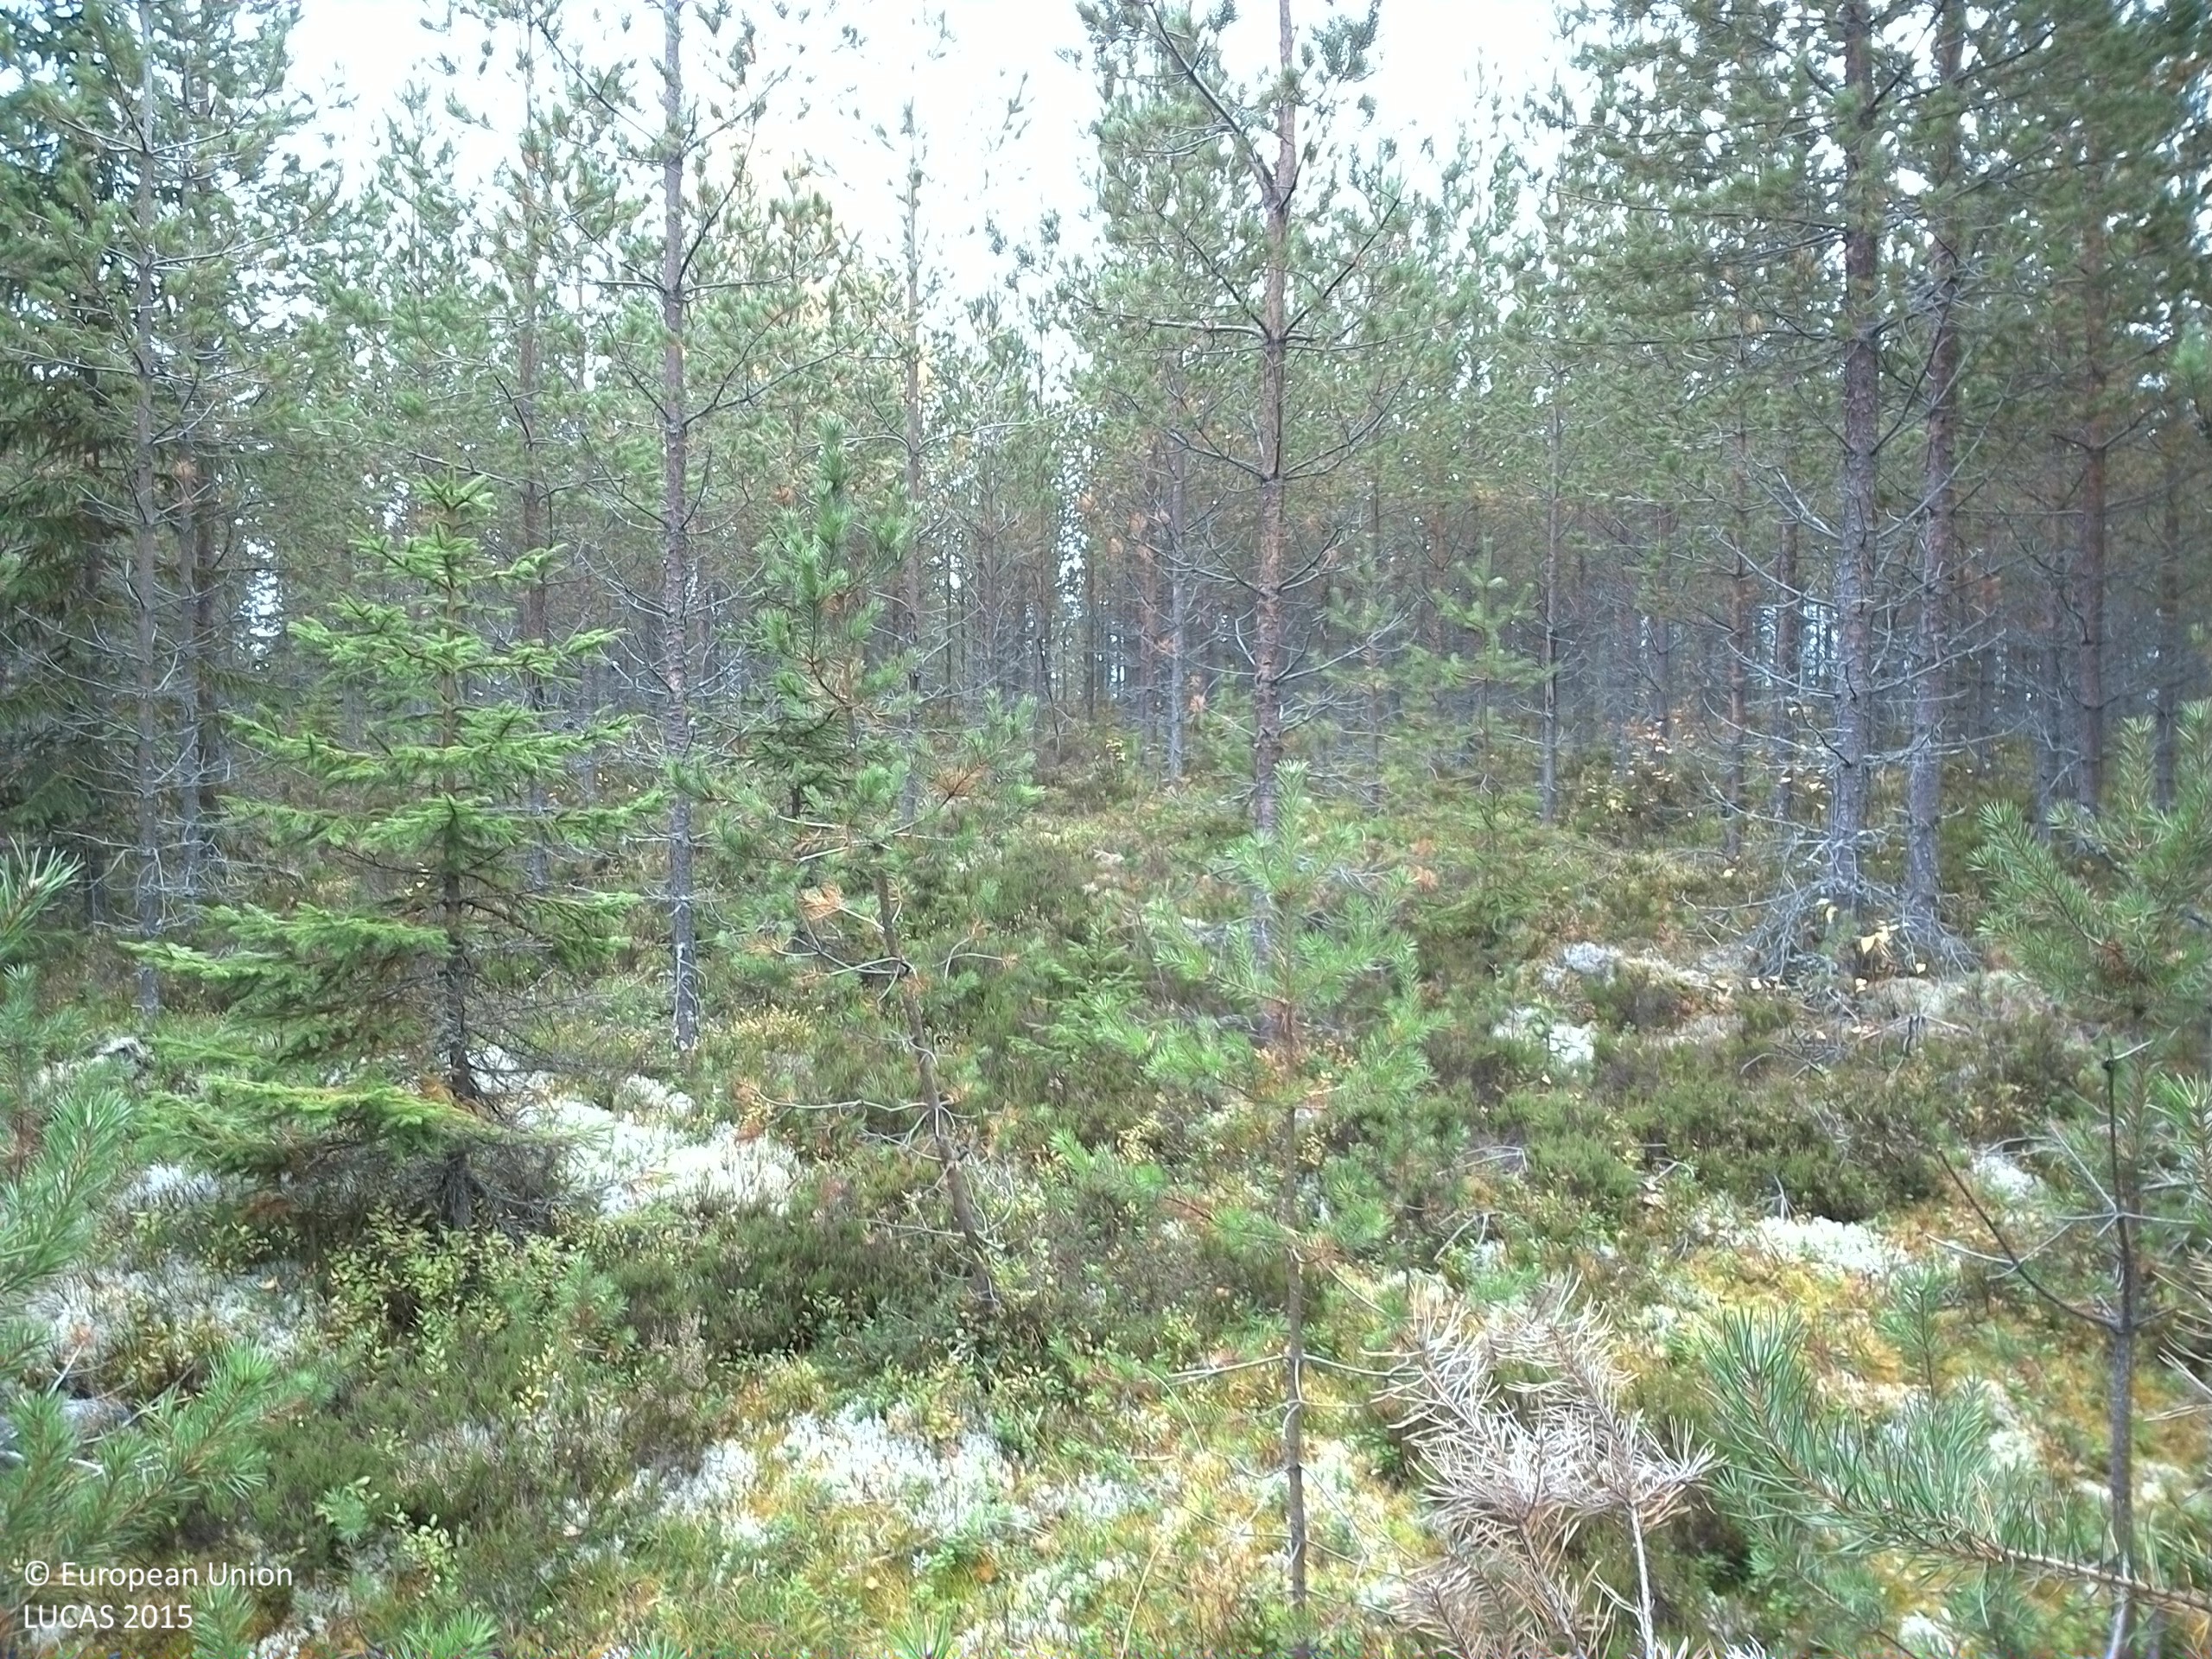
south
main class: Woodland
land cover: Pine dominated coniferous woodland
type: boreal forest
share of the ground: 50 - 75 %
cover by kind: coniferous forest trees 70 %, shrubs 20 %, lichens and mosses 10 %
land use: Forestry
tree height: < 5 m
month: October
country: SE
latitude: 61.2594
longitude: 14.6278
